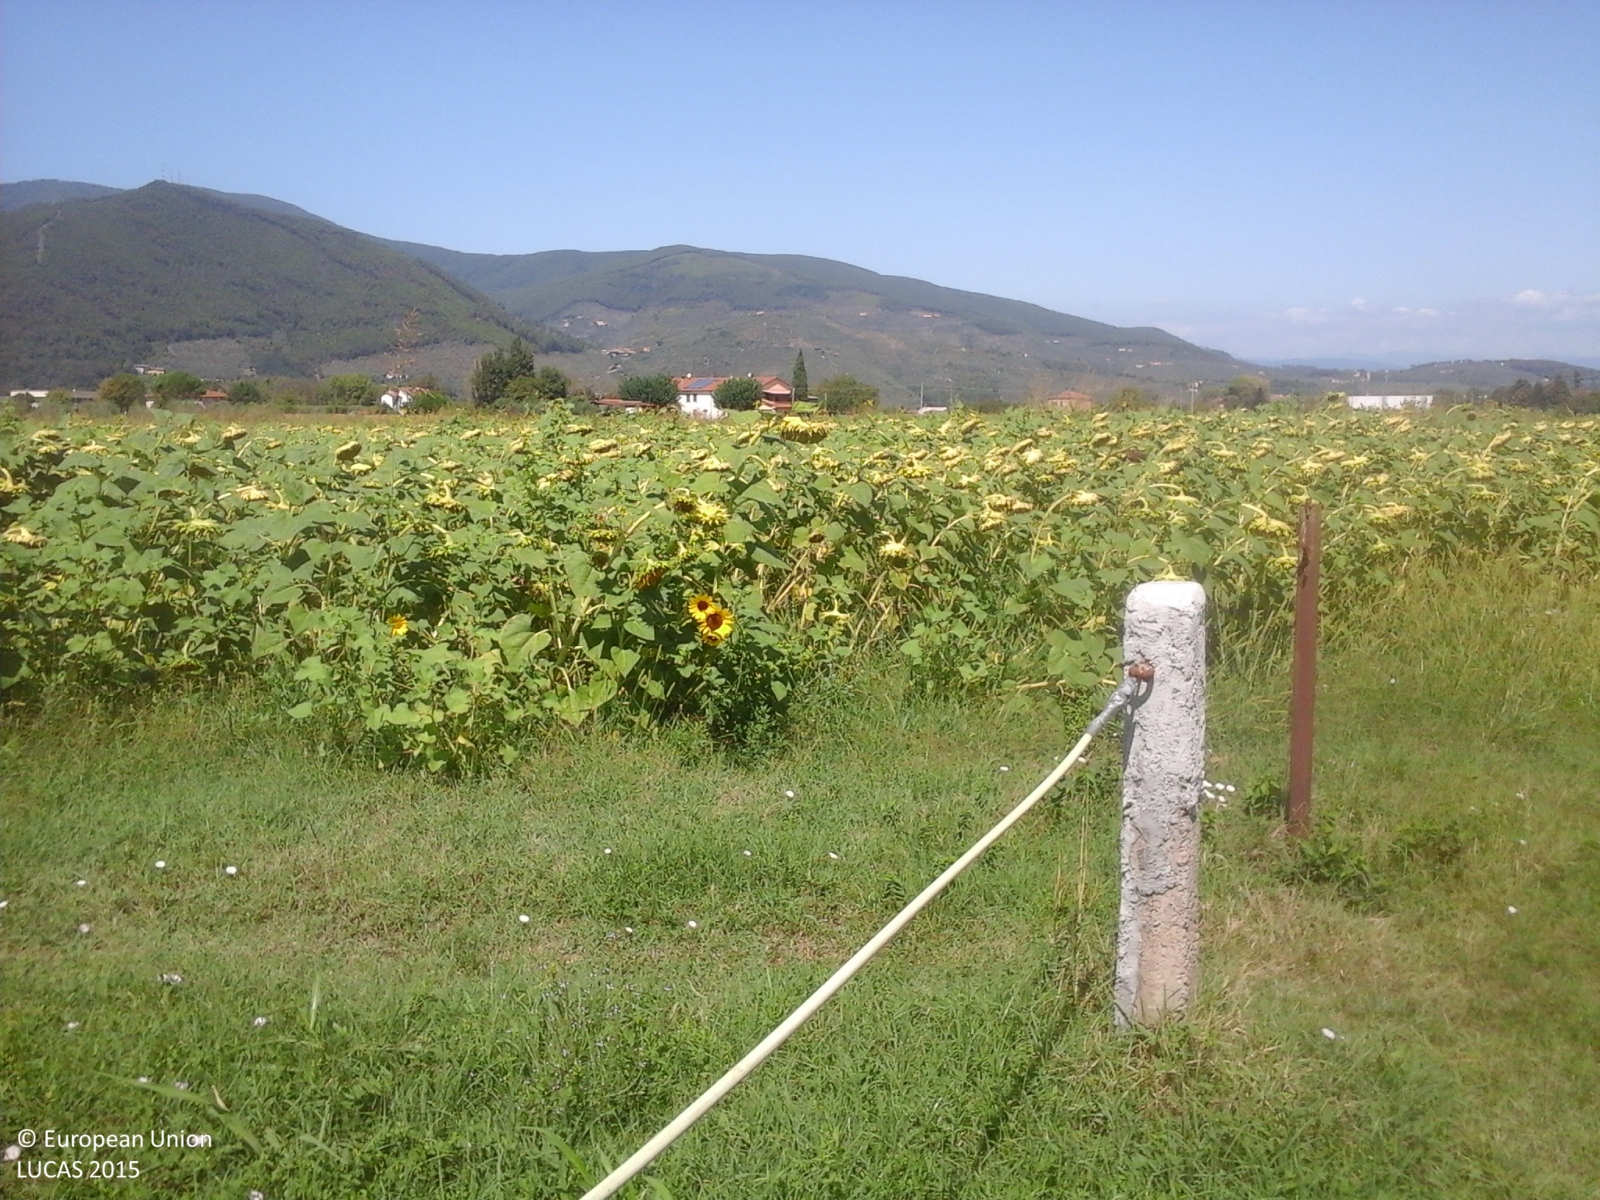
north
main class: Cropland
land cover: Sunflower
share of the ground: > 75 %
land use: Agriculture (excluding fallow land and kitchen gardens)
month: August
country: IT
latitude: 43.6993
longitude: 10.6064
